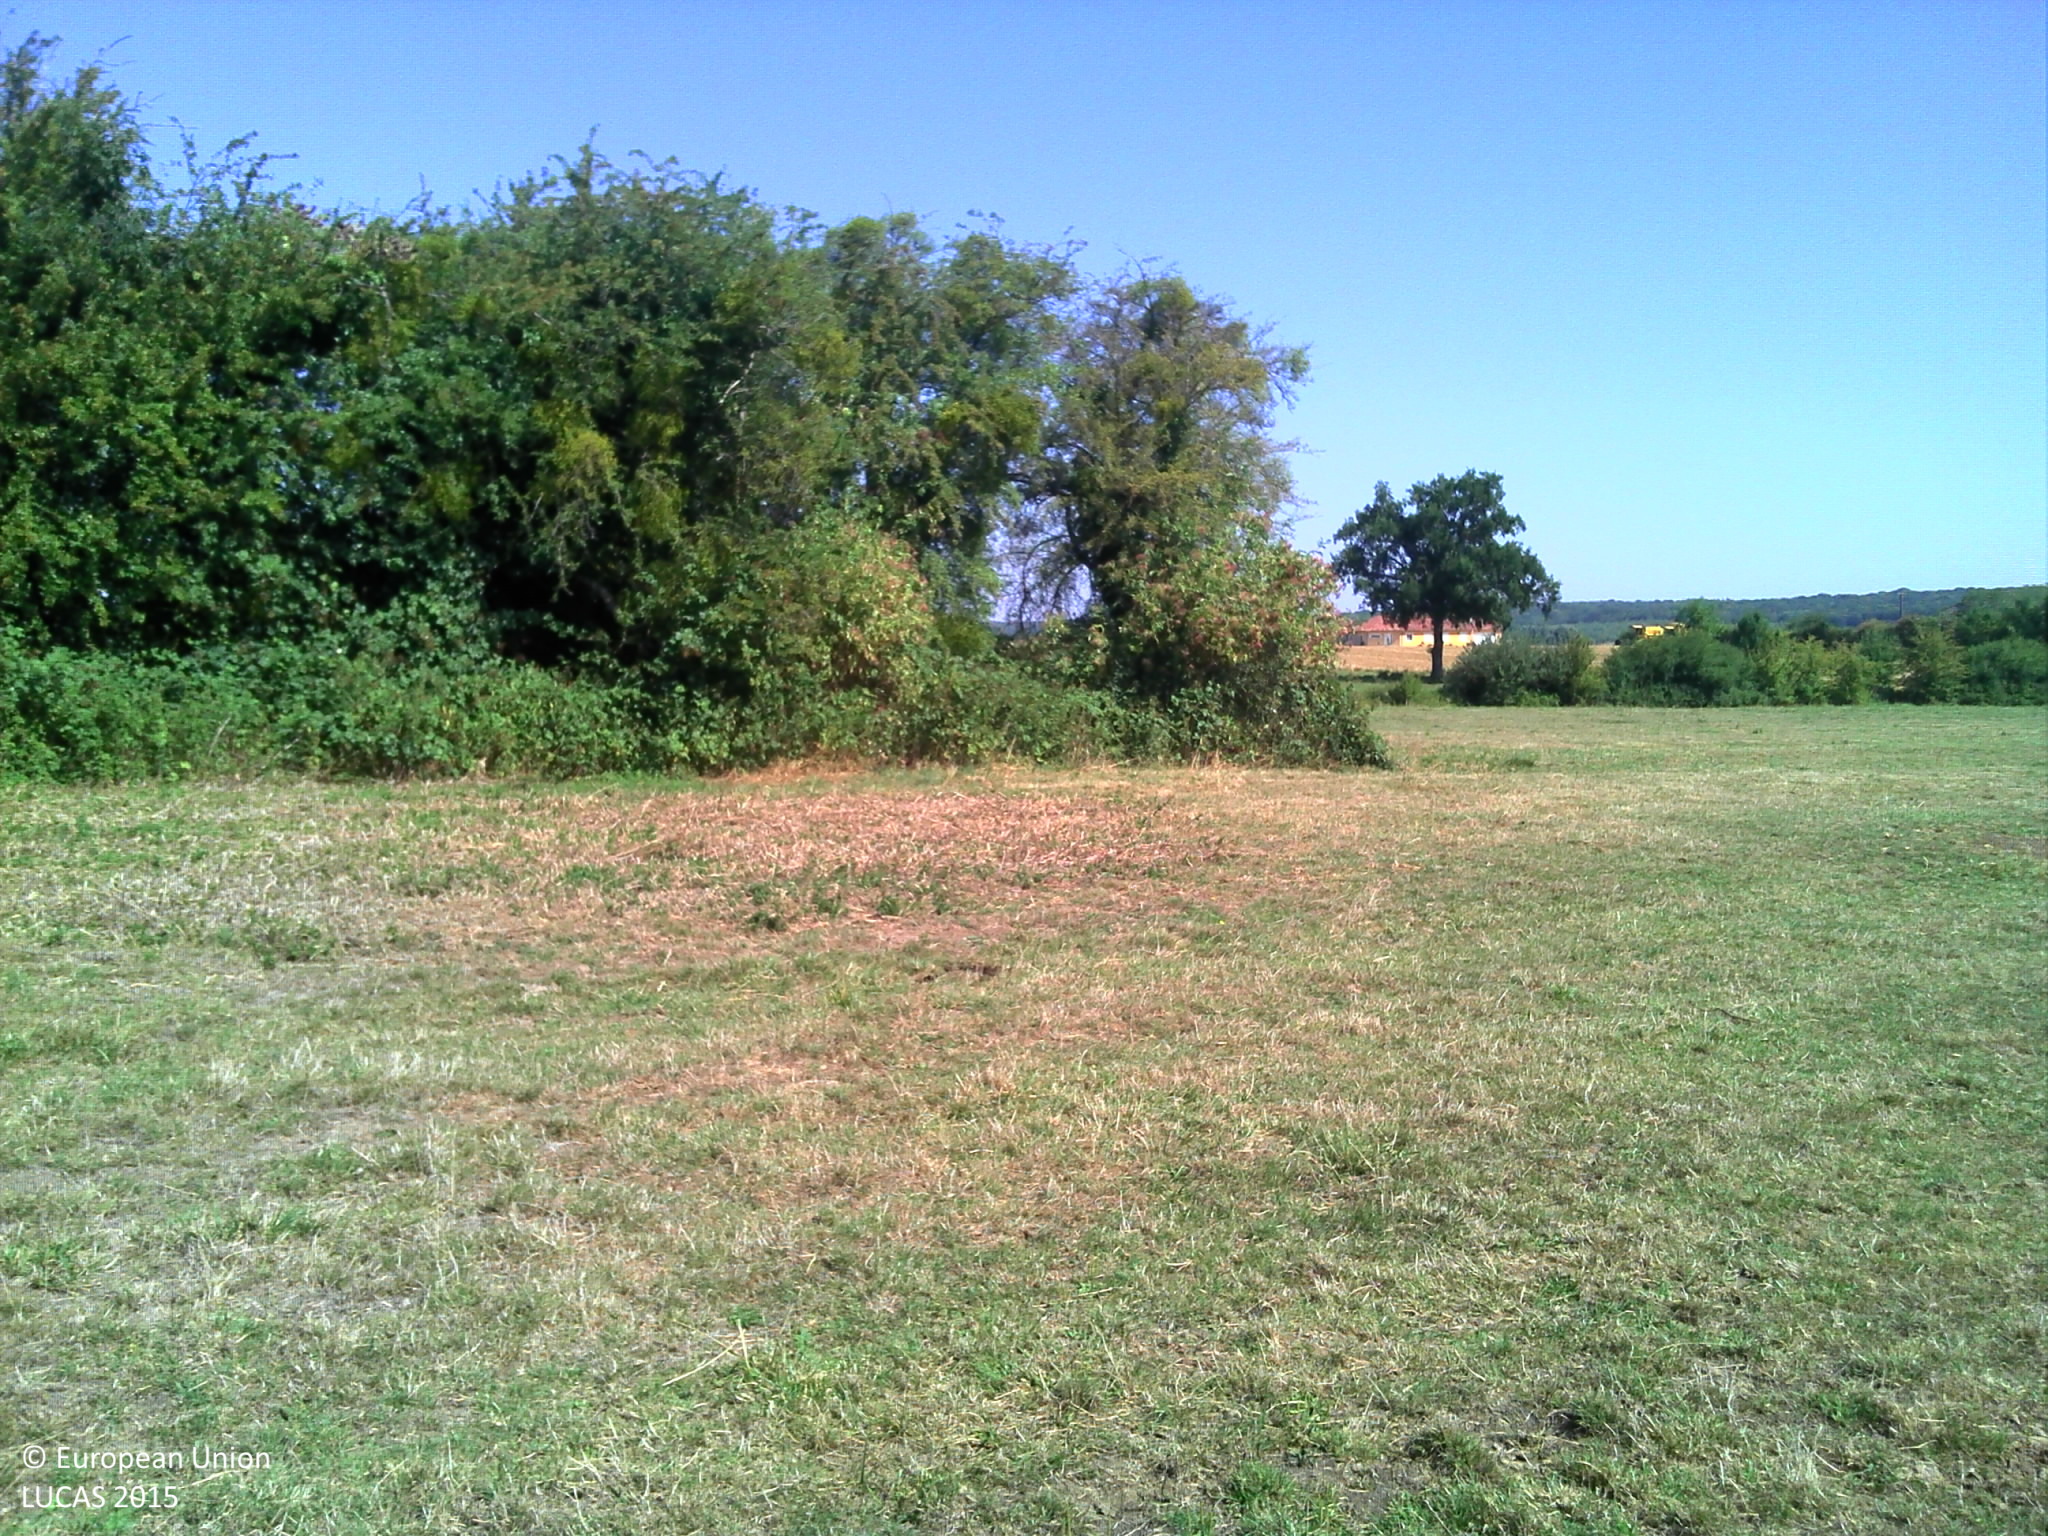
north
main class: Grassland
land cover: Grassland without tree/shrub cover
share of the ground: > 75 %
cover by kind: herbaceous plants 100 %
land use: Agriculture (excluding fallow land and kitchen gardens)
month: August
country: FR
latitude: 49.4496
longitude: 5.1286
